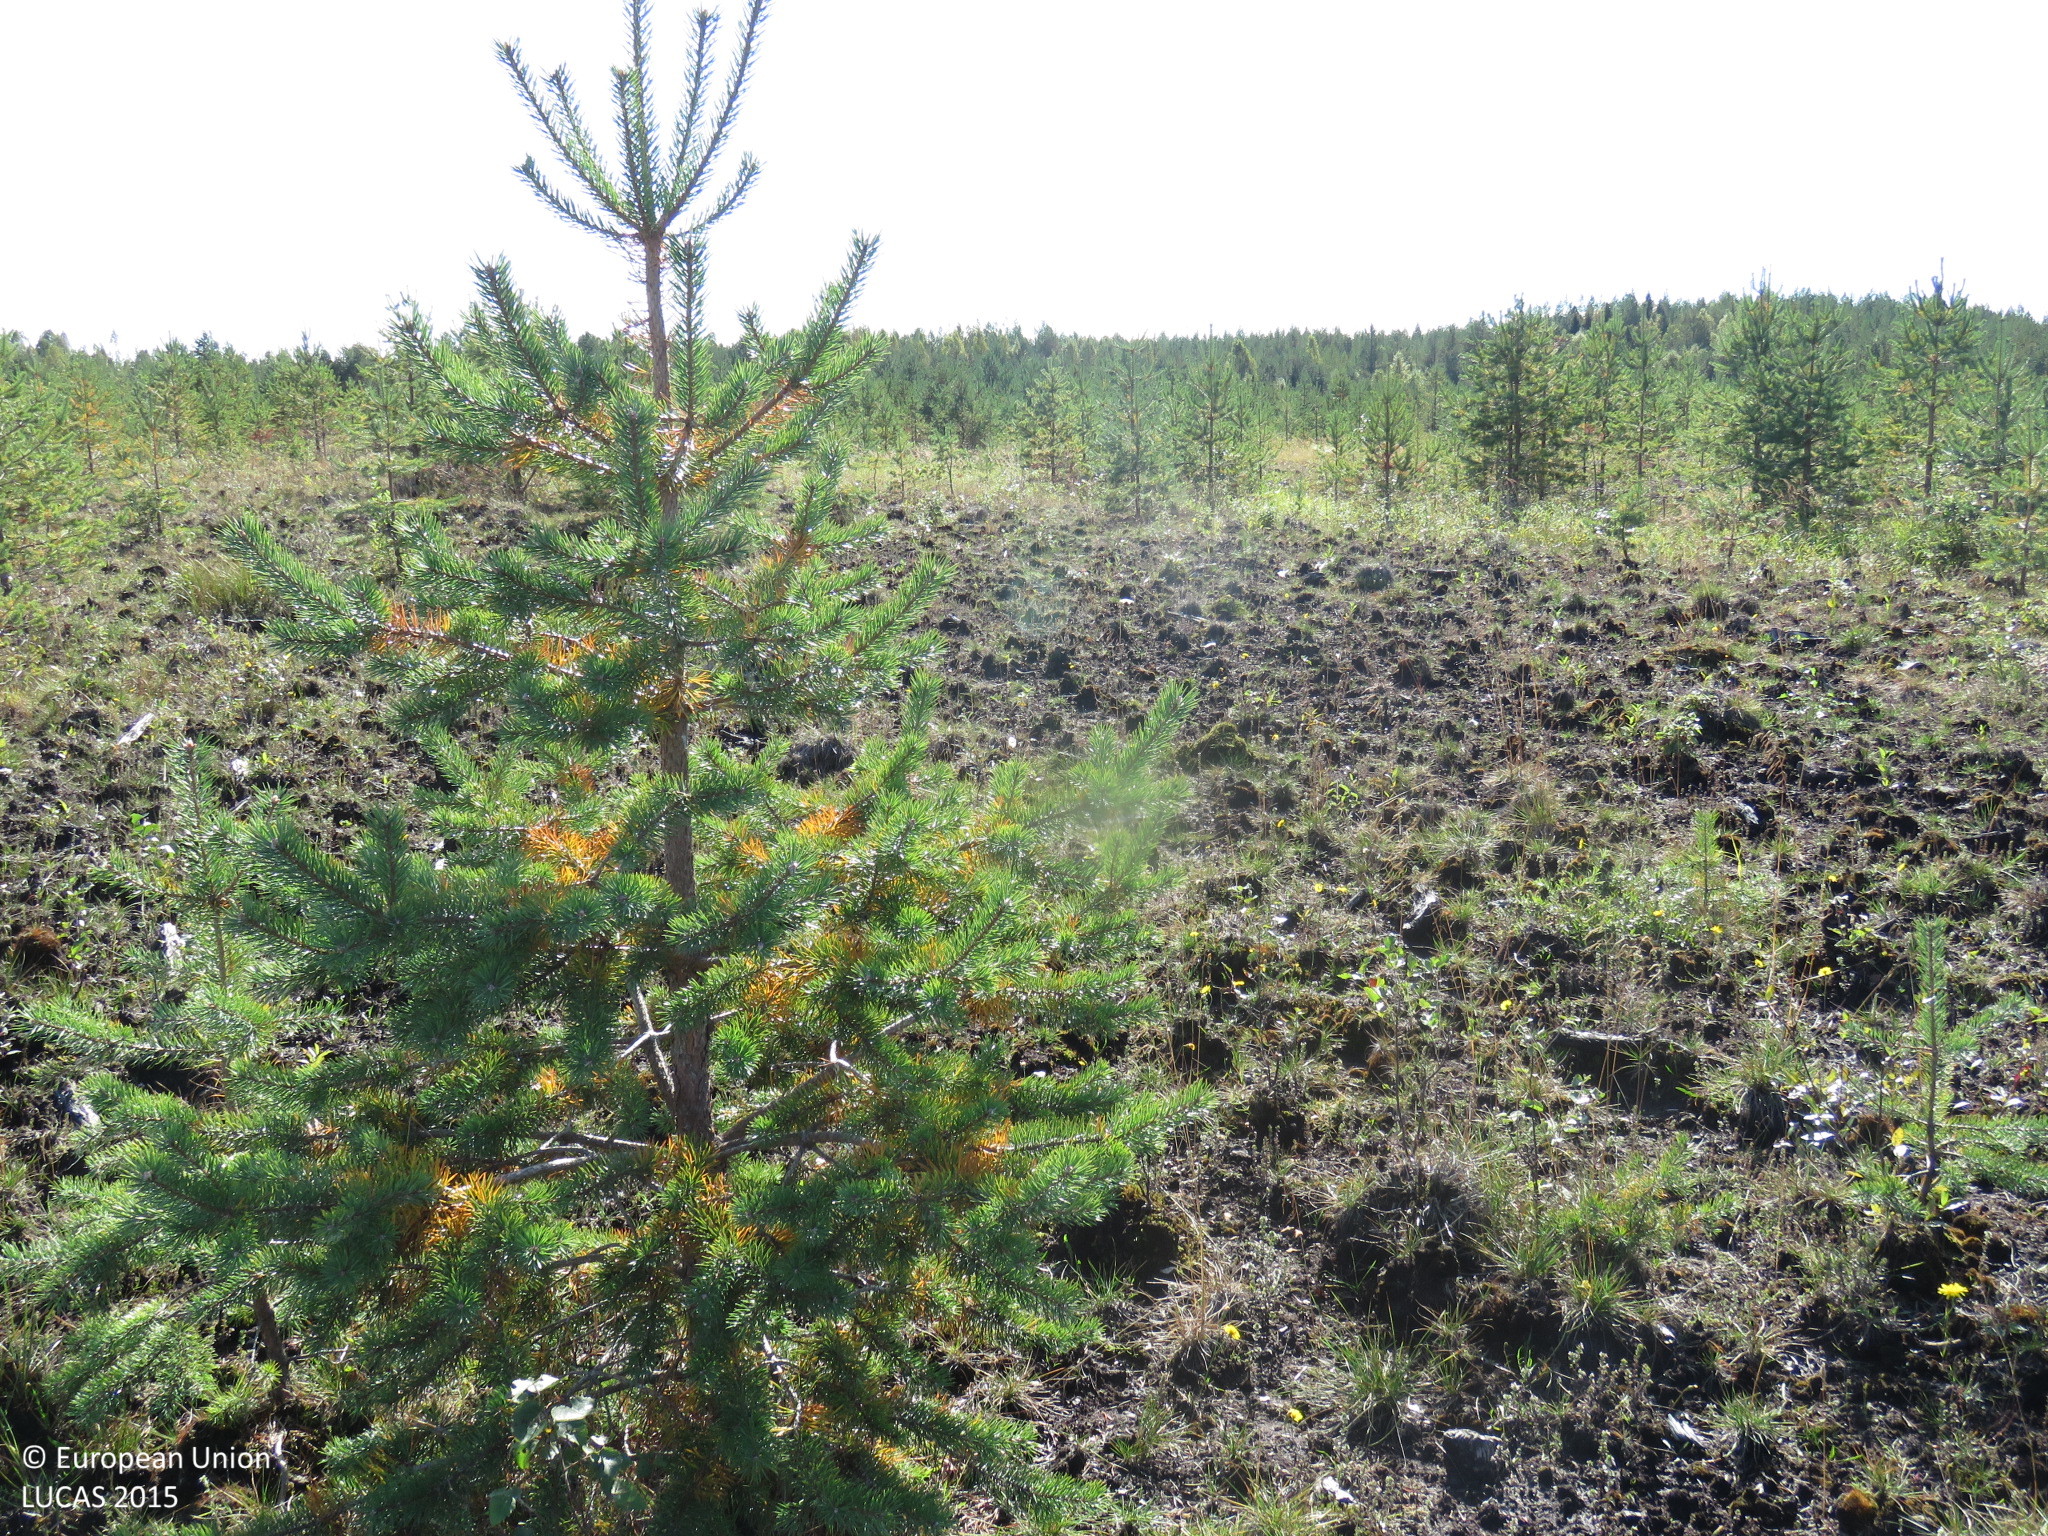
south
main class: Woodland
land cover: Pine dominated mixed woodland
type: mire and swamp forests
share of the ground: 10 - 25 %
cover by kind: unconsolidated bare surface 50 %, herbaceous plants 30 %, coniferous forest trees 10 %, broadleaved forest trees 5 %, lichens and mosses 5 %
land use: Abandoned areas
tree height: < 5 m
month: August
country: FI
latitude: 65.2770
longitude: 26.0576
